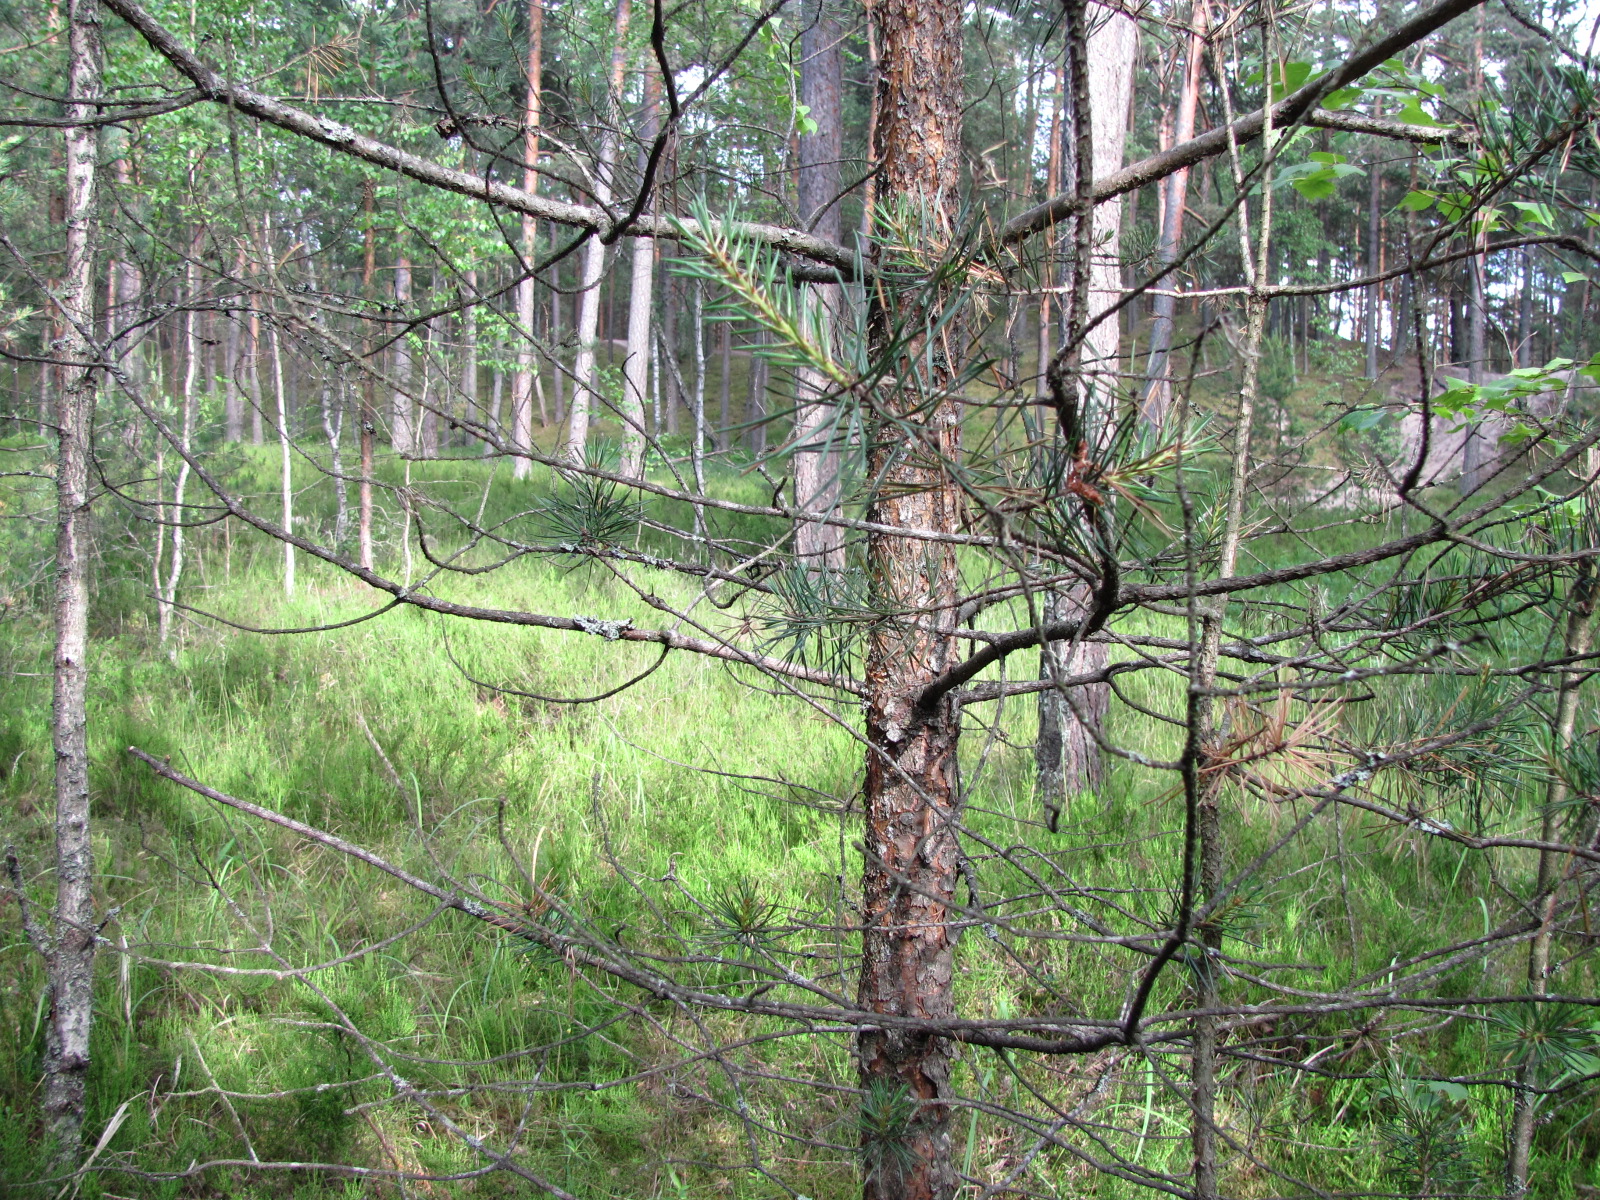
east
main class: Woodland
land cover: Pine dominated coniferous woodland
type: hemiboreal forest and nemoral coniferous forest and mixed broadleaved-coniferous forest
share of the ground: > 75 %
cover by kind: coniferous forest trees 80 %, herbaceous plants 10 %, broadleaved forest trees 5 %, lichens and mosses 5 %
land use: Forestry
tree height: > 5 m
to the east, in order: Pine dominated coniferous woodland; Tracks; Pine dominated mixed woodland; Pine dominated coniferous woodland
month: June
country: LV
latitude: 57.0063
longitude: 23.9961
